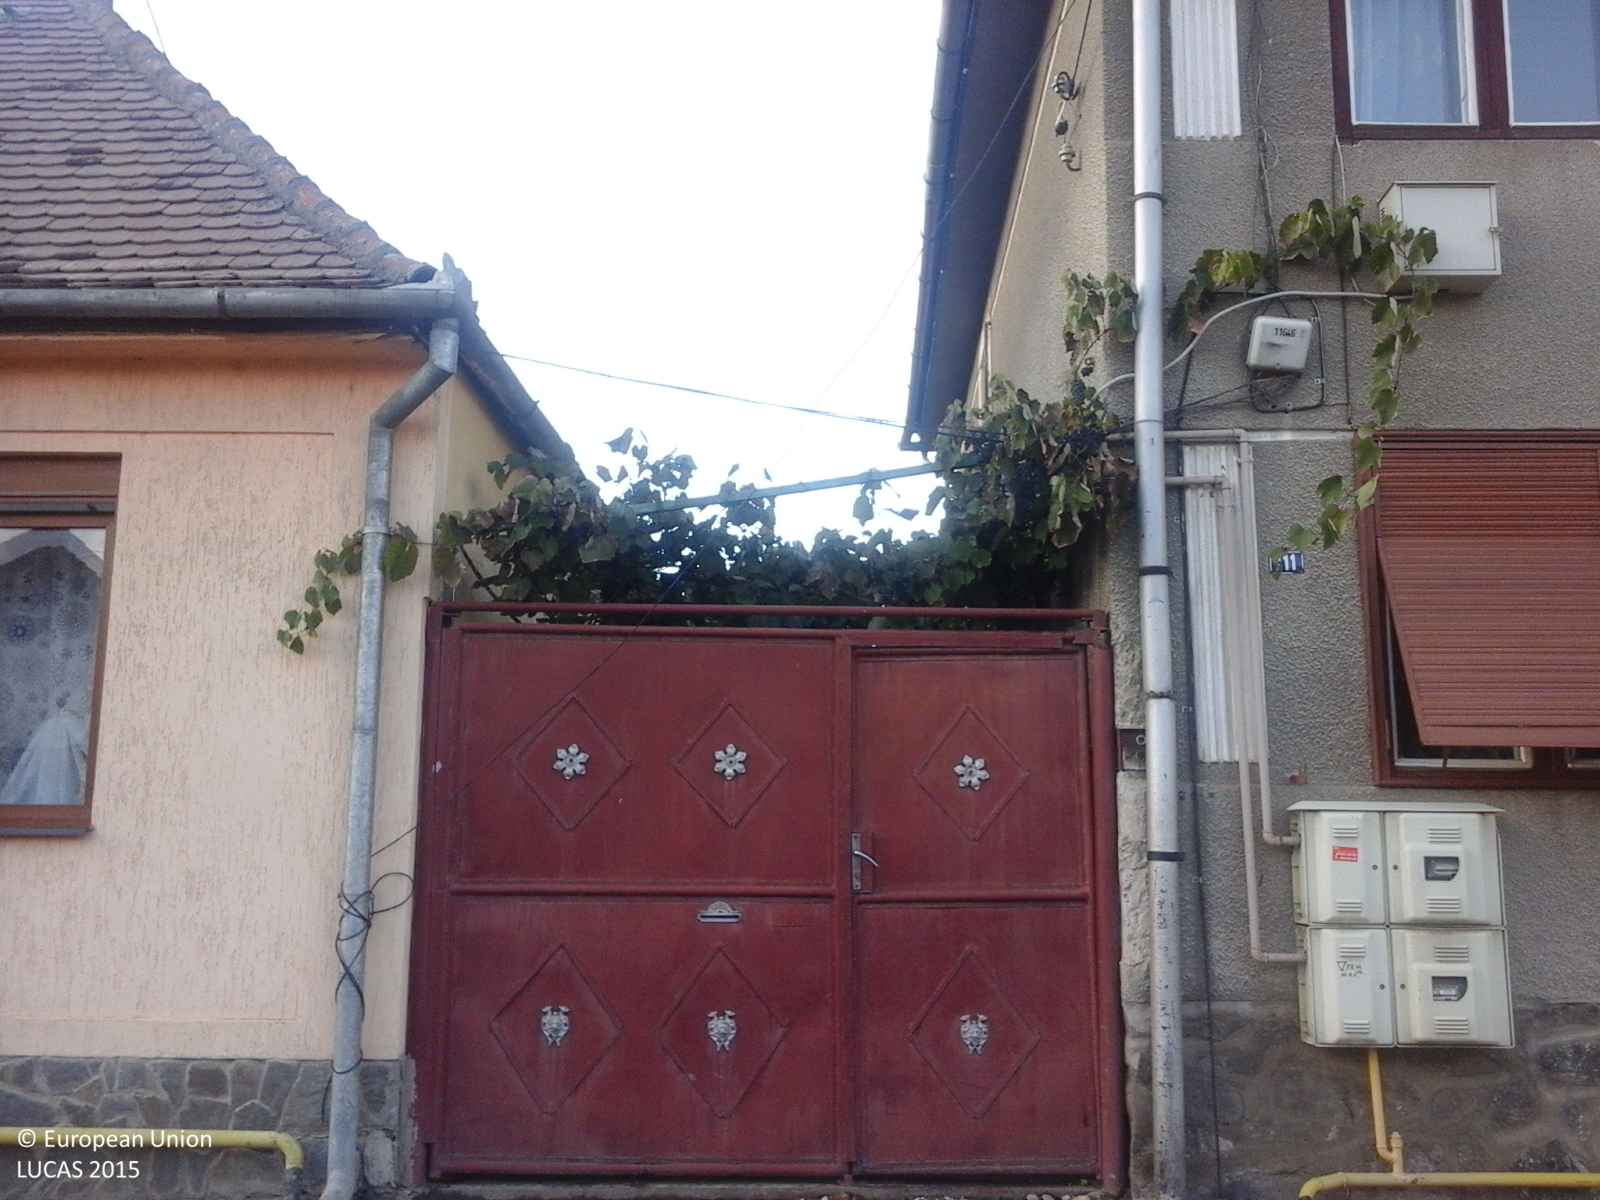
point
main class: Cropland
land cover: Vineyards
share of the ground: > 75 %
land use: Agriculture (excluding fallow land and kitchen gardens)
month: October
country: RO
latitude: 45.8082
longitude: 24.1395
